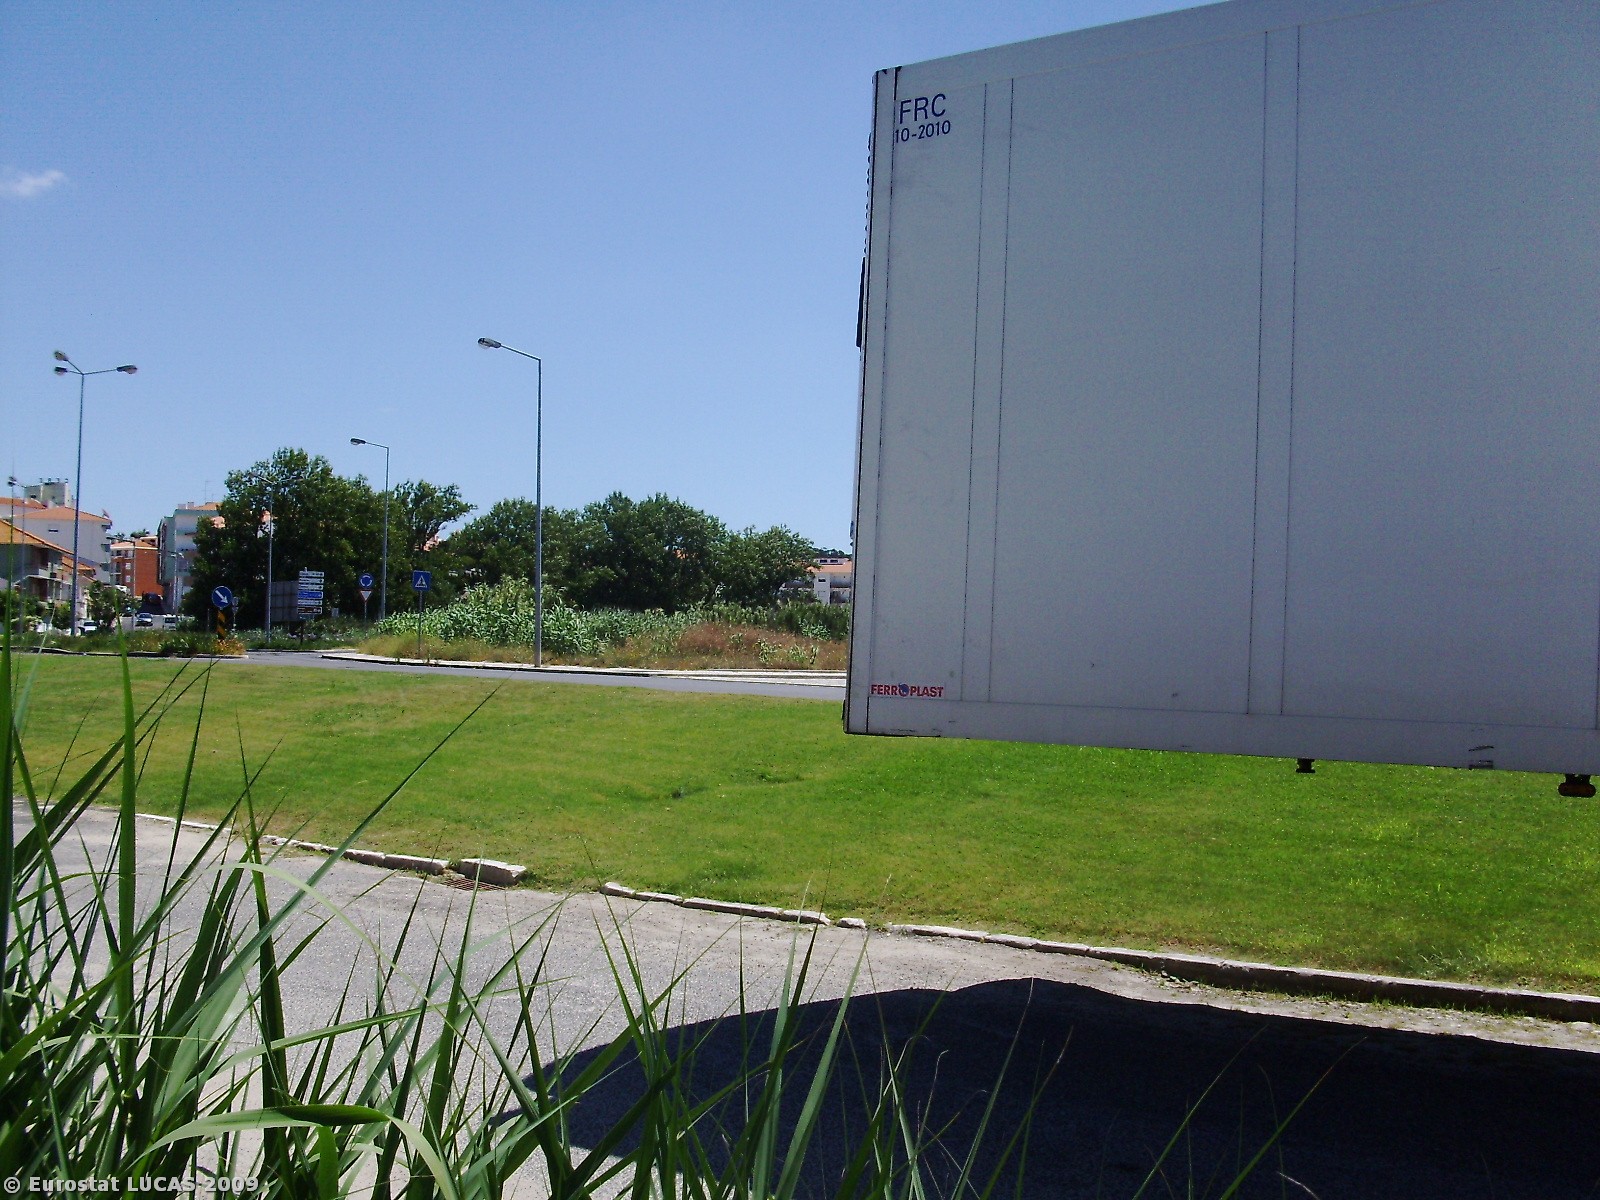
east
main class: Shrubland
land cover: Shrubland without tree cover
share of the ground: > 75 %
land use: Fallow land
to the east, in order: Shrubland without tree cover; Electric lines; Paved roads, cycling and walking lanes; Spontaneously vegetated surfaces; Paved roads, cycling and walking lanes; Spontaneously vegetated surfaces; Shrubland without tree cover; Paved roads, cycling and walking lanes; Shrubland without tree cover; Rivers and streams
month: July
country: PT
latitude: 39.3997
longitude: -9.1448
